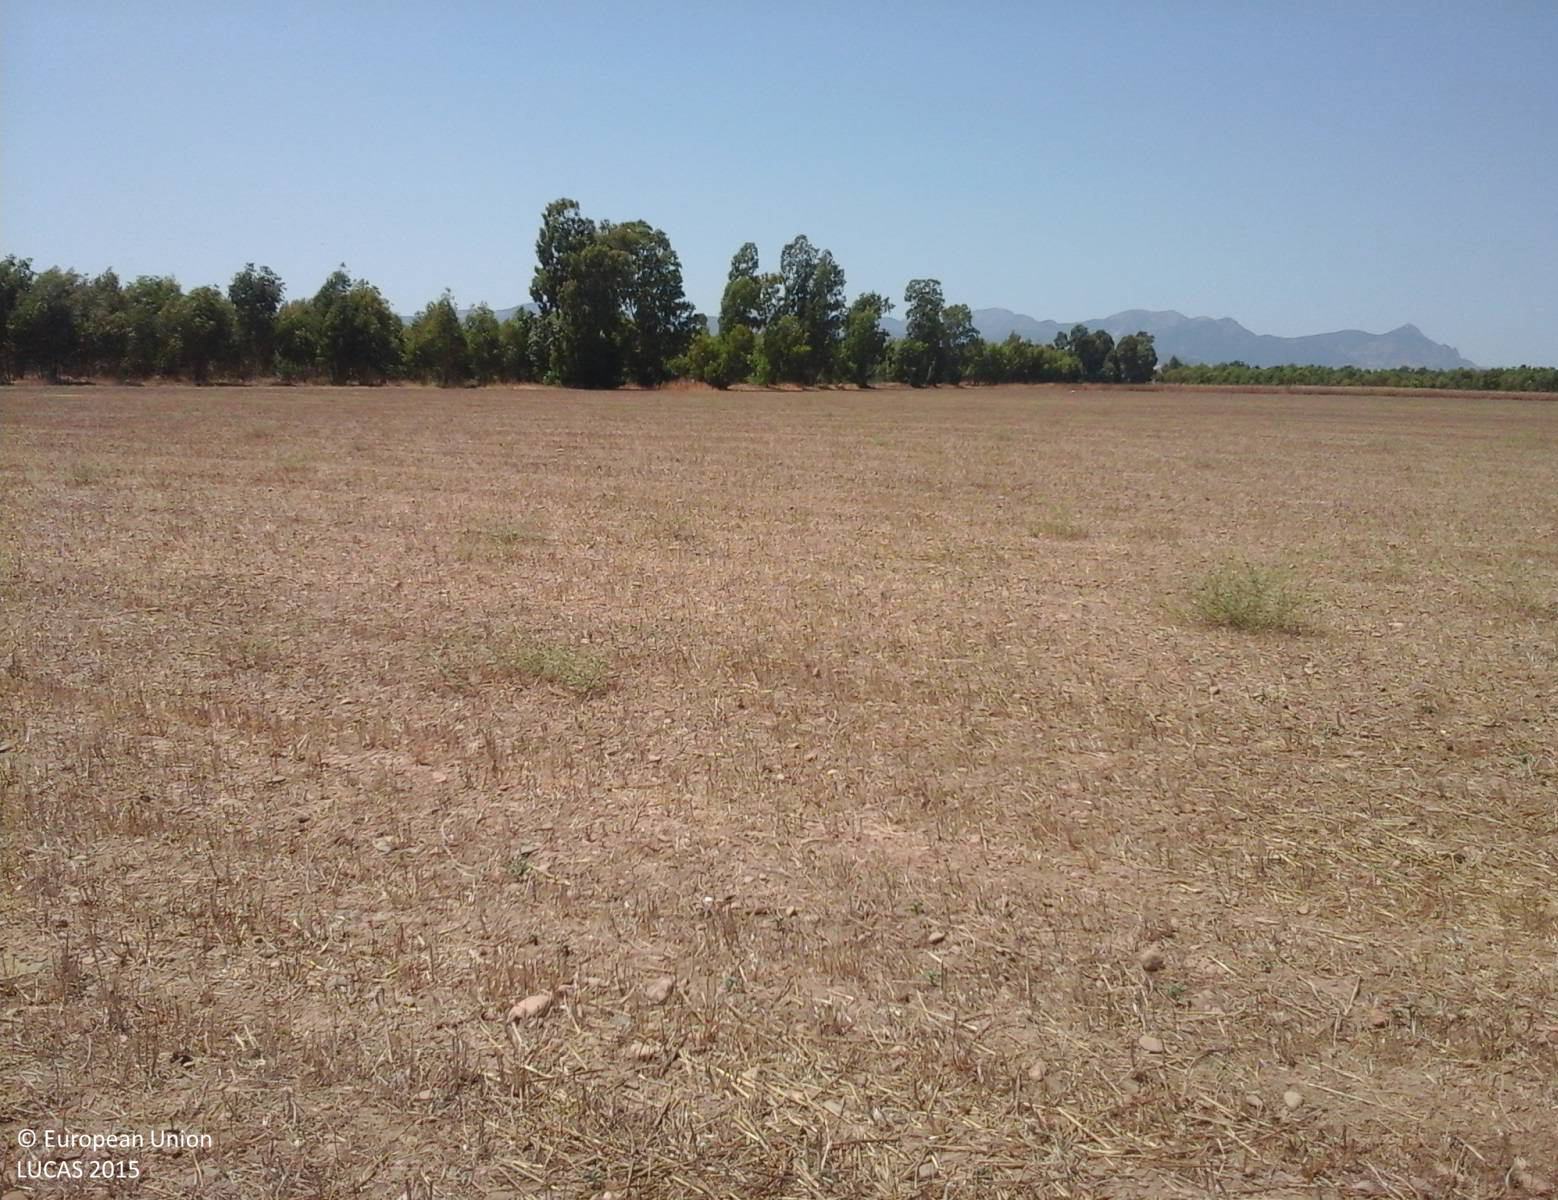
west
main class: Cropland
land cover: Mixed cereals for fodder
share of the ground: > 75 %
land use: Agriculture (excluding fallow land and kitchen gardens)
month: August
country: IT
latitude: 39.3737
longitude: 8.9039
